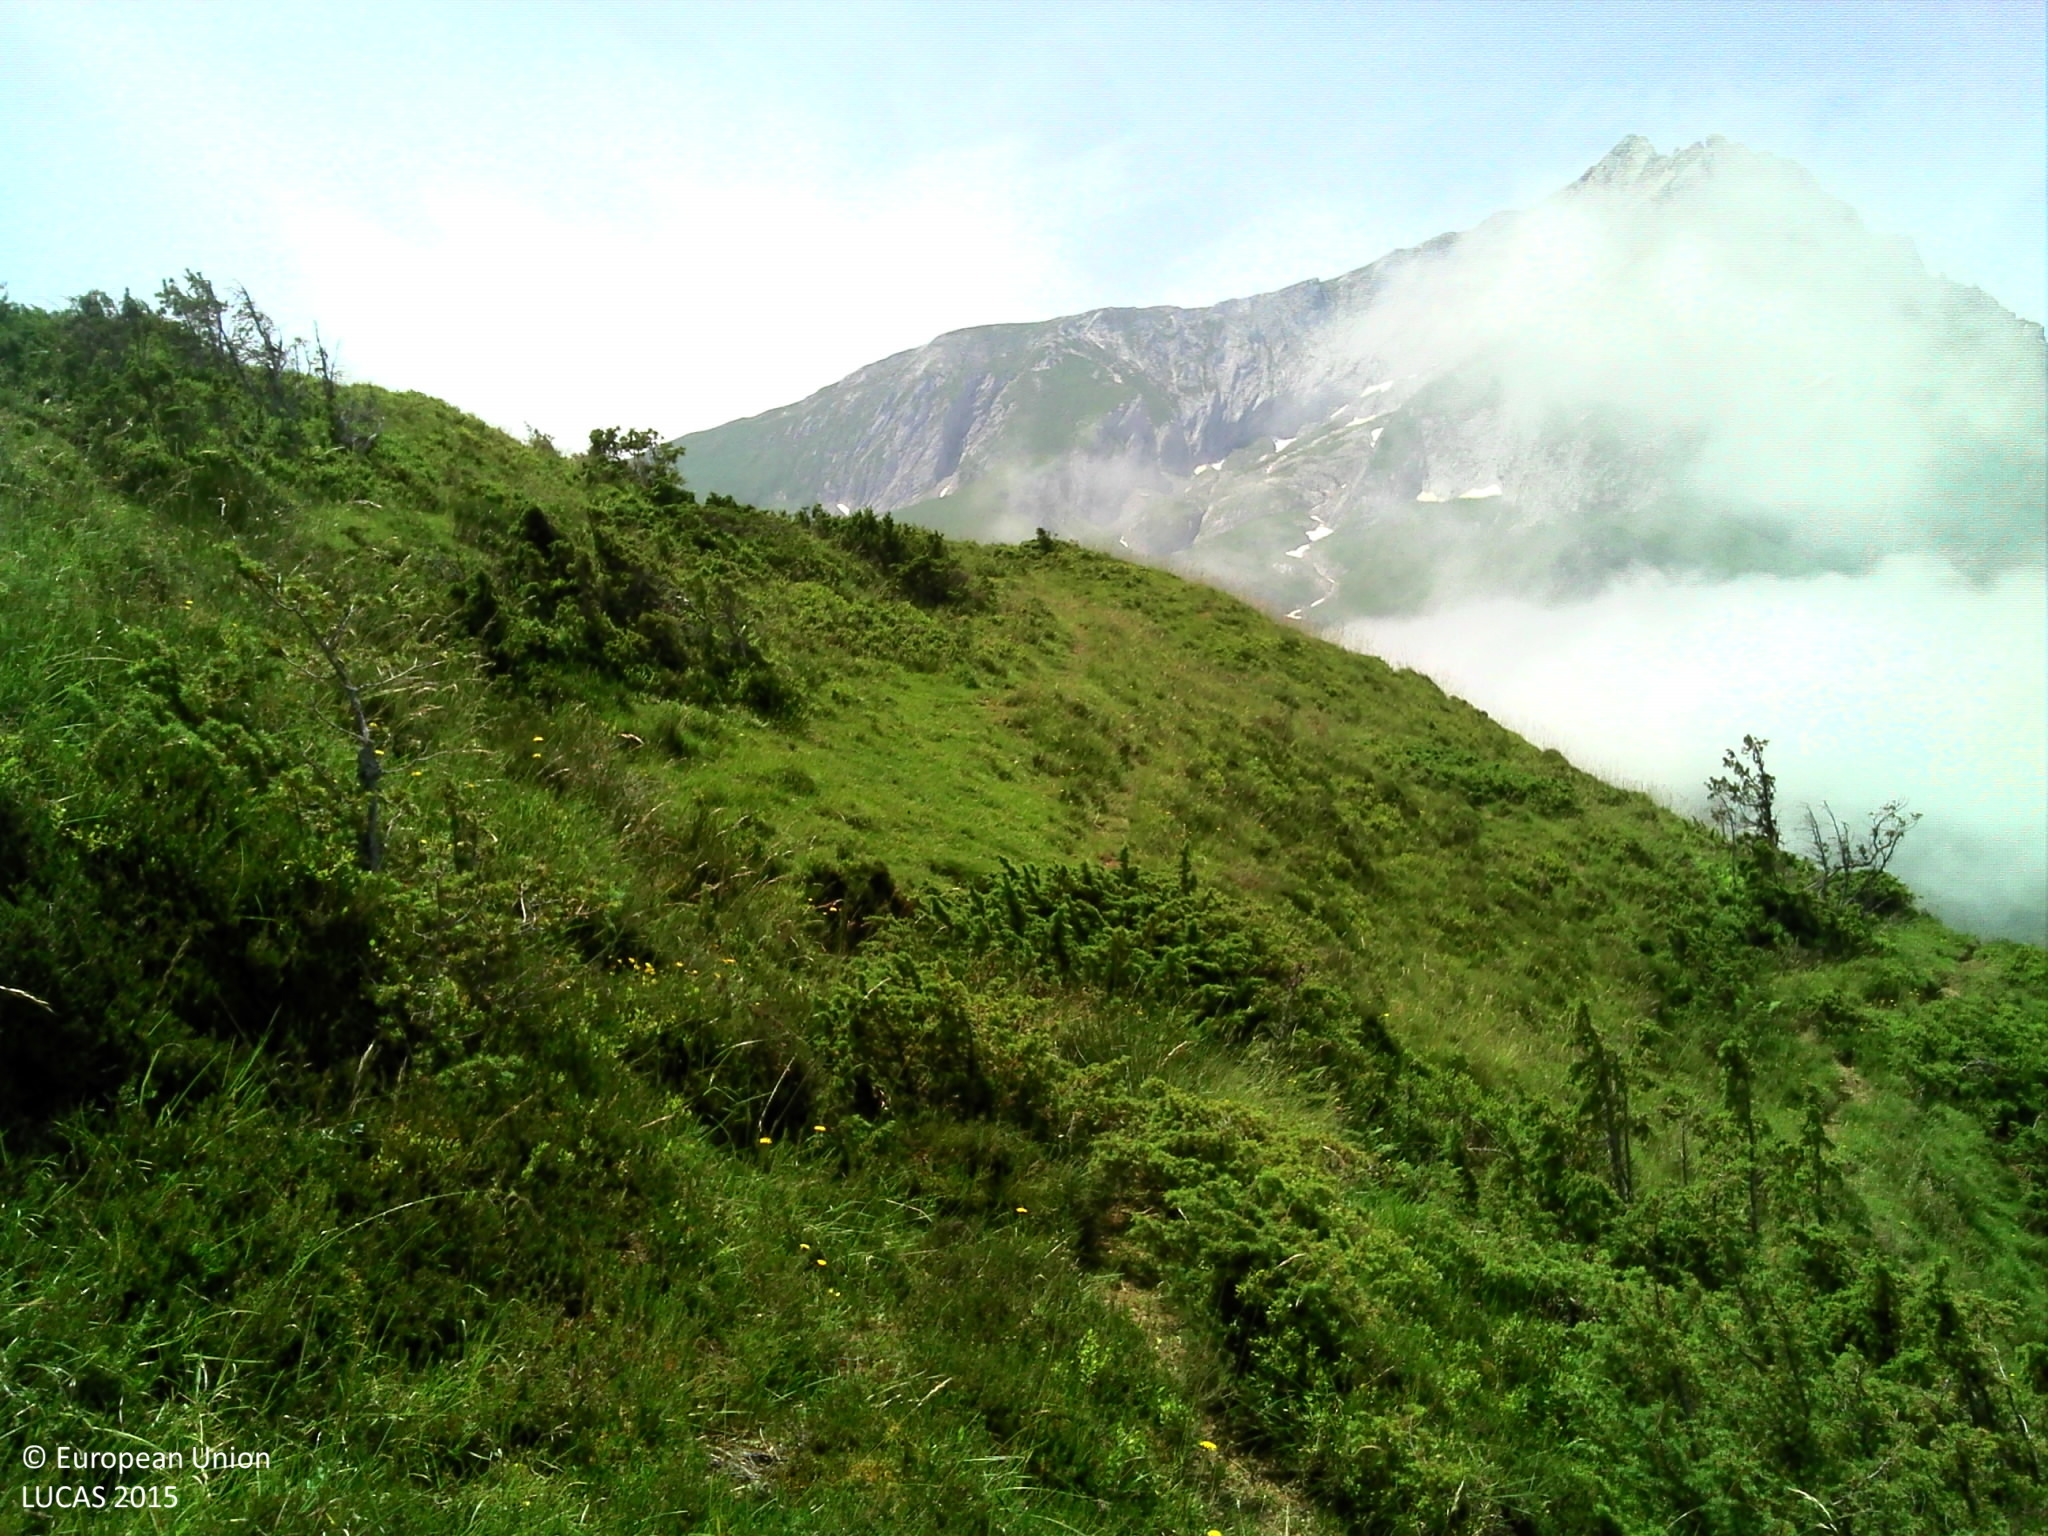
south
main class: Shrubland
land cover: Shrubland without tree cover
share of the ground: > 75 %
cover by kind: shrubs 60 %, herbaceous plants 40 %
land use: Agriculture (excluding fallow land and kitchen gardens)
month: July
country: FR
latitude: 42.9677
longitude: -0.2655
